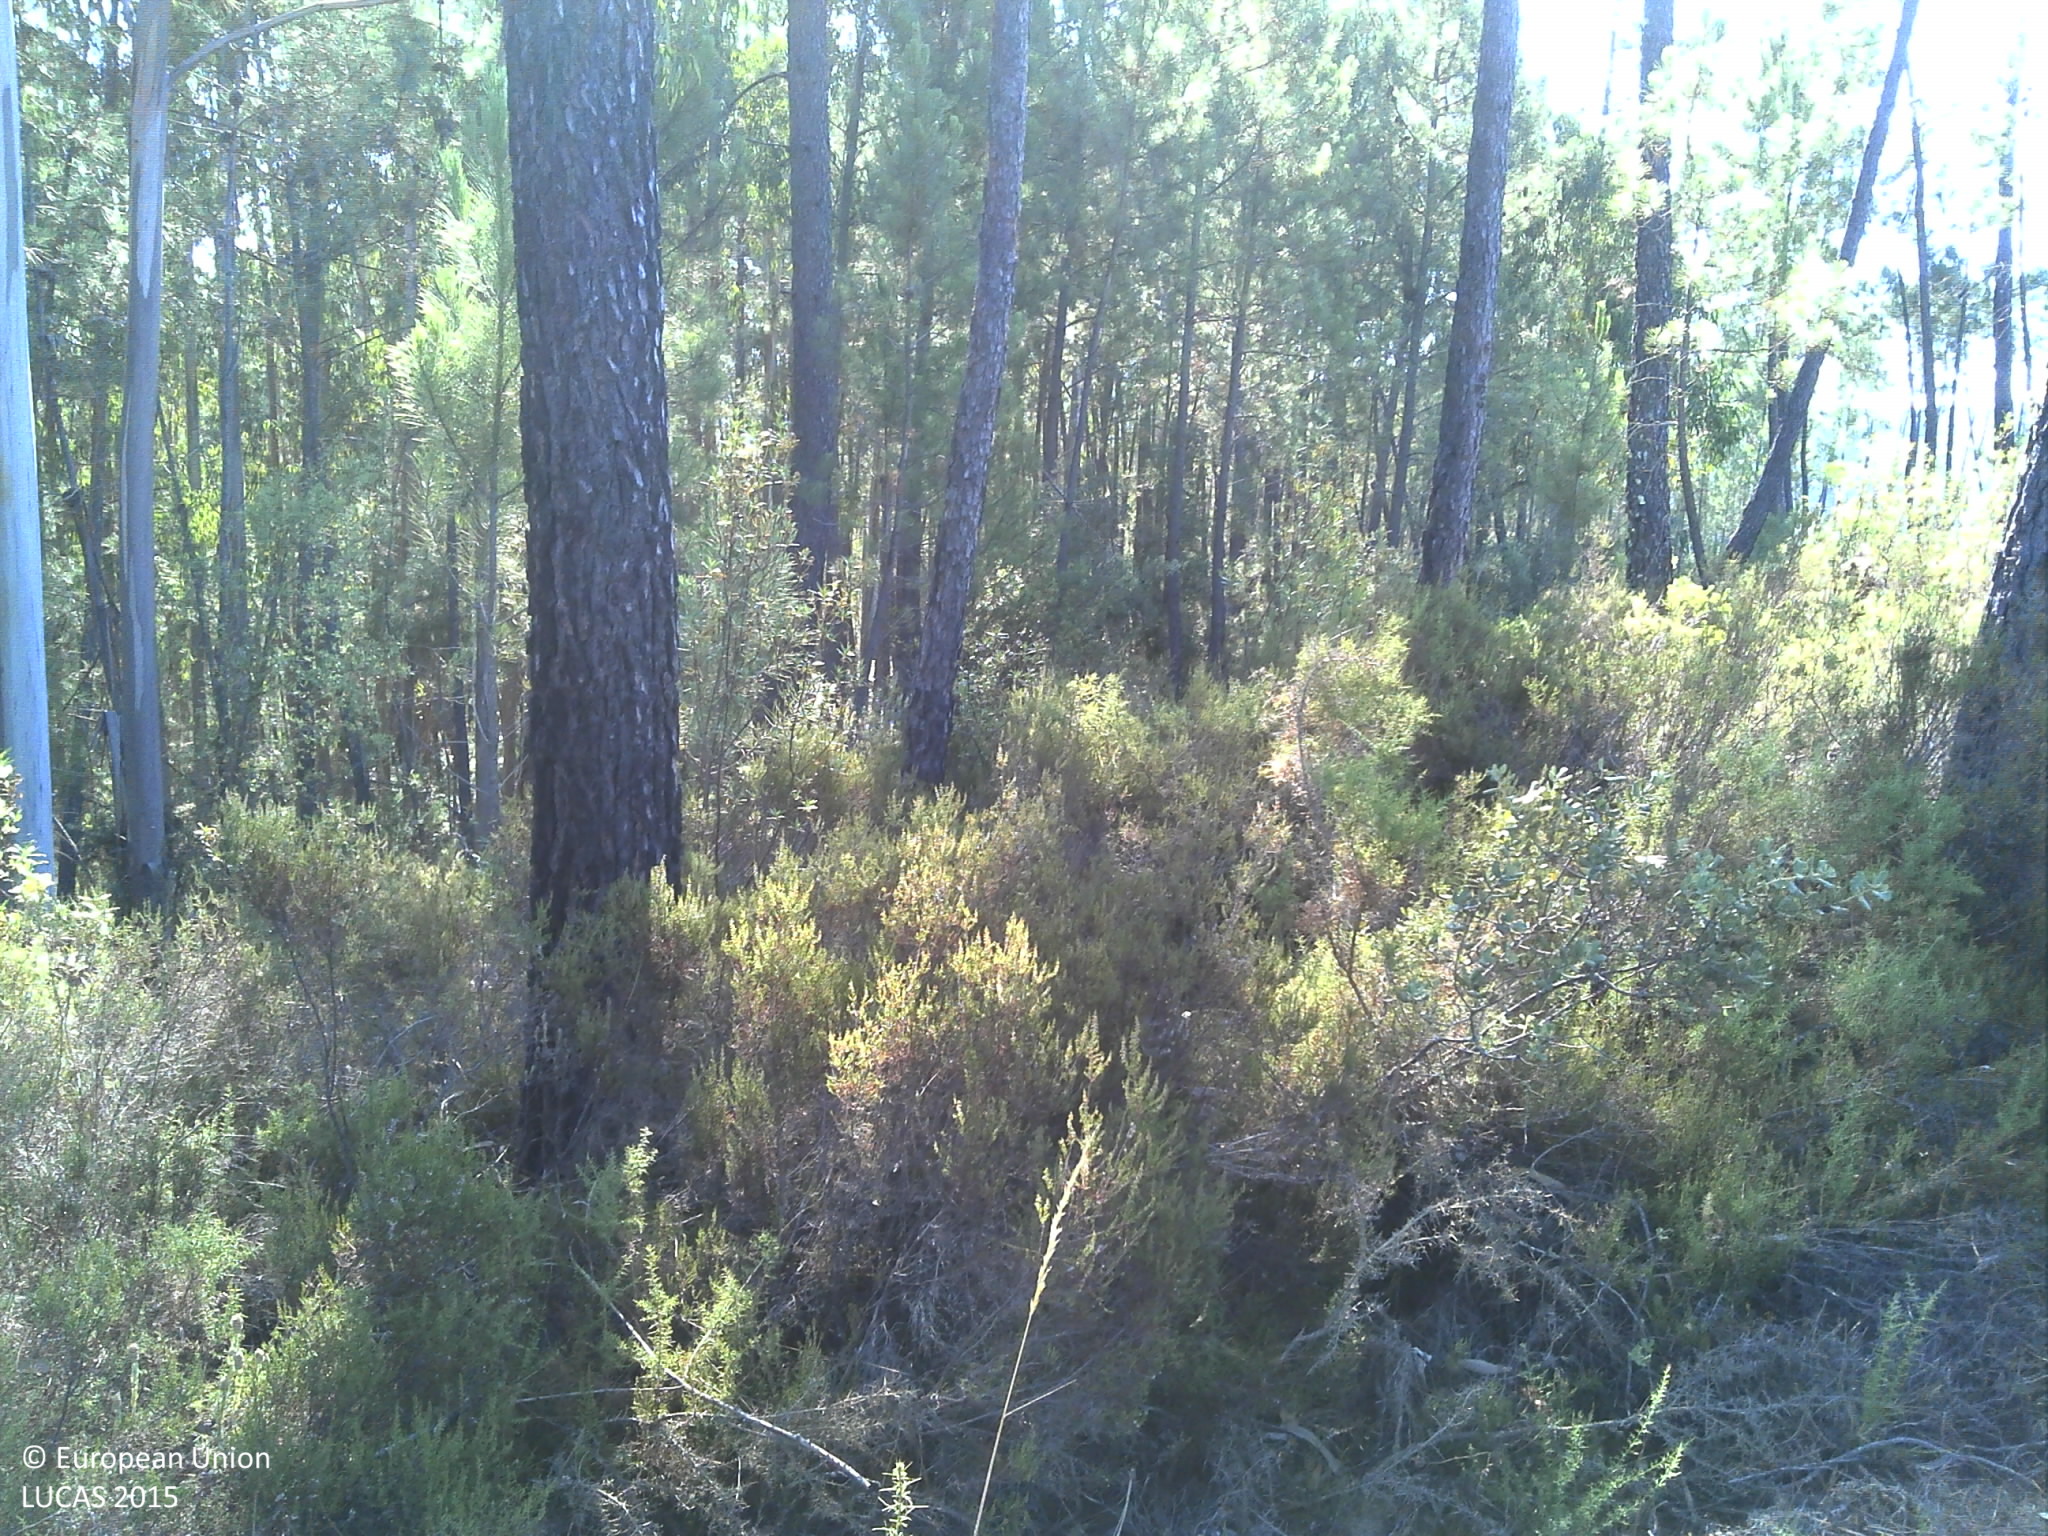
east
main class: Woodland
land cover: Pine dominated coniferous woodland
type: coniferous forest of the mediterranean region
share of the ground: 10 - 25 %
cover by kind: shrubs 70 %, coniferous forest trees 30 %
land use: Forestry
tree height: > 5 m
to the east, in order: Pine dominated coniferous woodland; Tracks; Pine dominated mixed woodland; Pine dominated coniferous woodland; Tracks; Broadleaved woodland; Pine dominated coniferous woodland
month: July
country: PT
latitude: 39.7731
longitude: -8.0804
